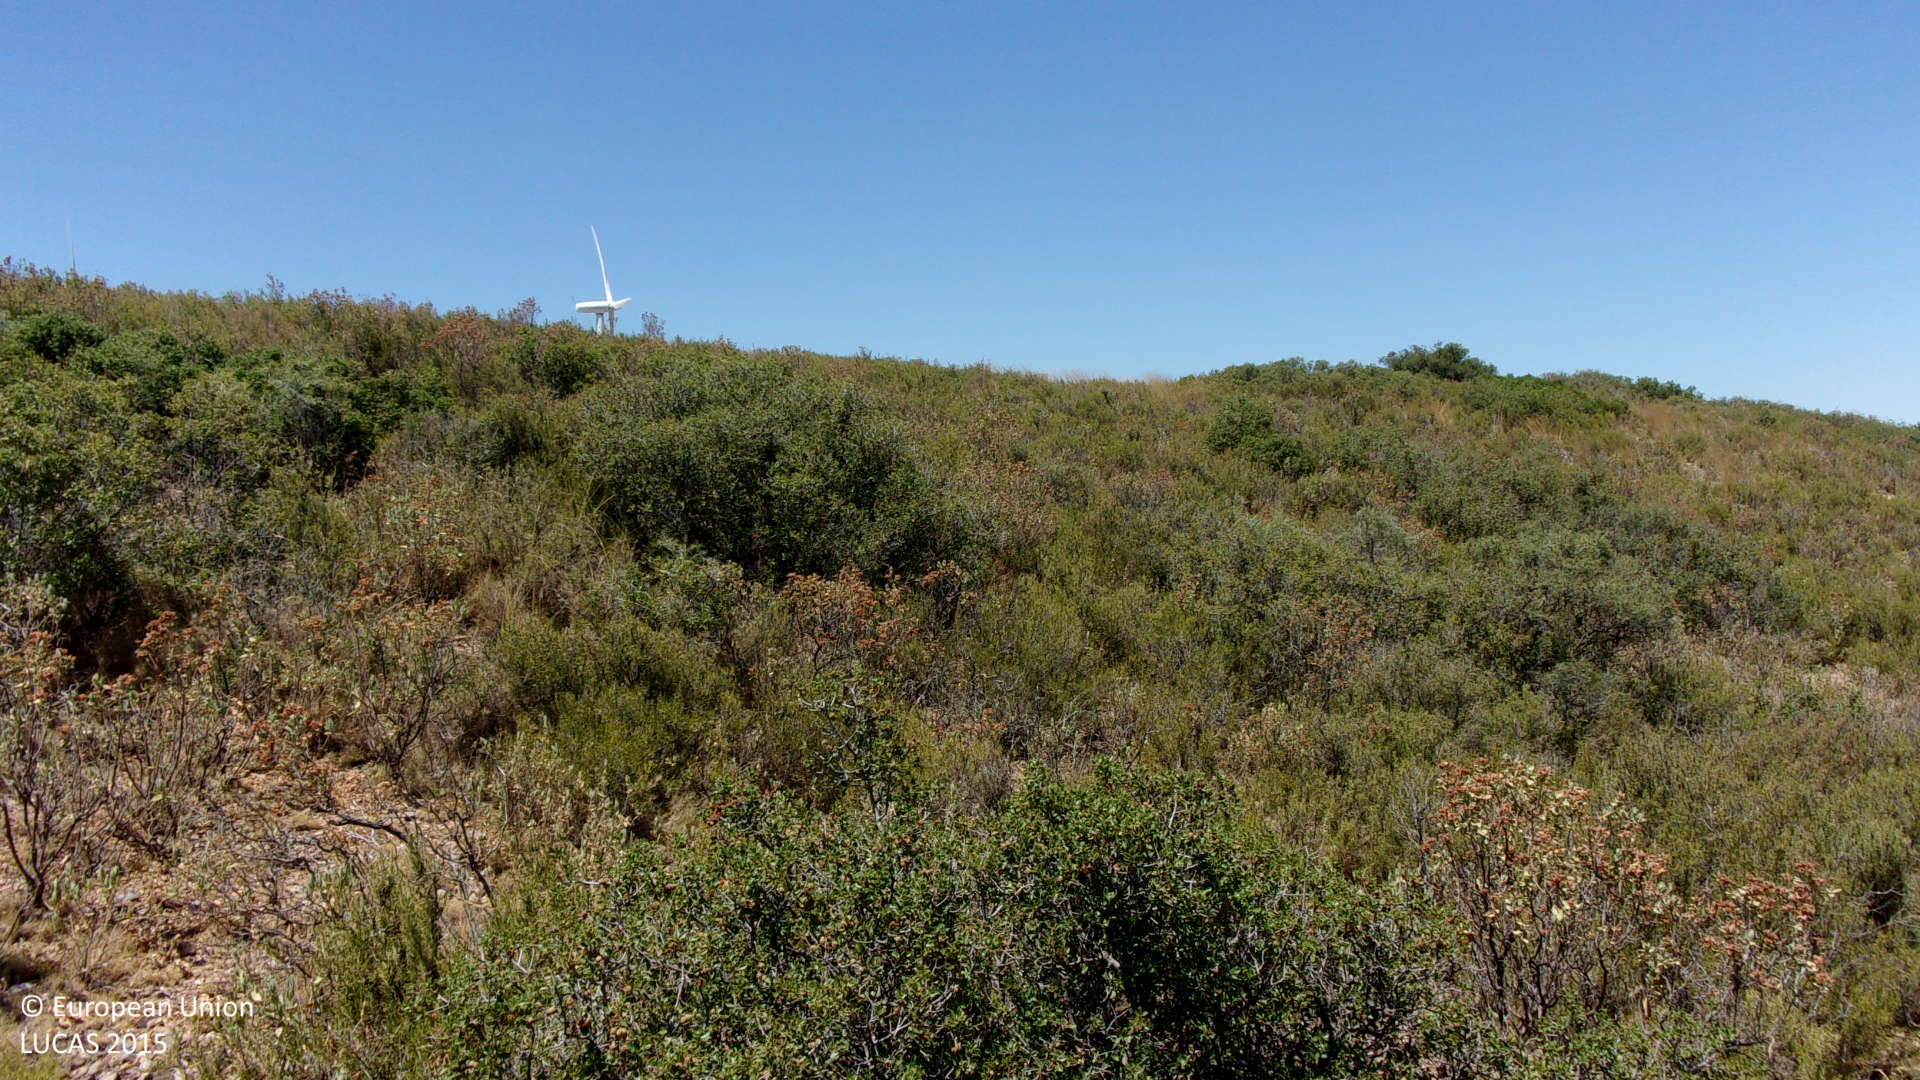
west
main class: Shrubland
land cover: Shrubland without tree cover
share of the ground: > 75 %
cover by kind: shrubs 85 %, consolidated bare surface 10 %, herbaceous plants 5 %
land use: Semi-natural and natural areas not in use
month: July
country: ES
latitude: 41.7140
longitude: -1.2633
